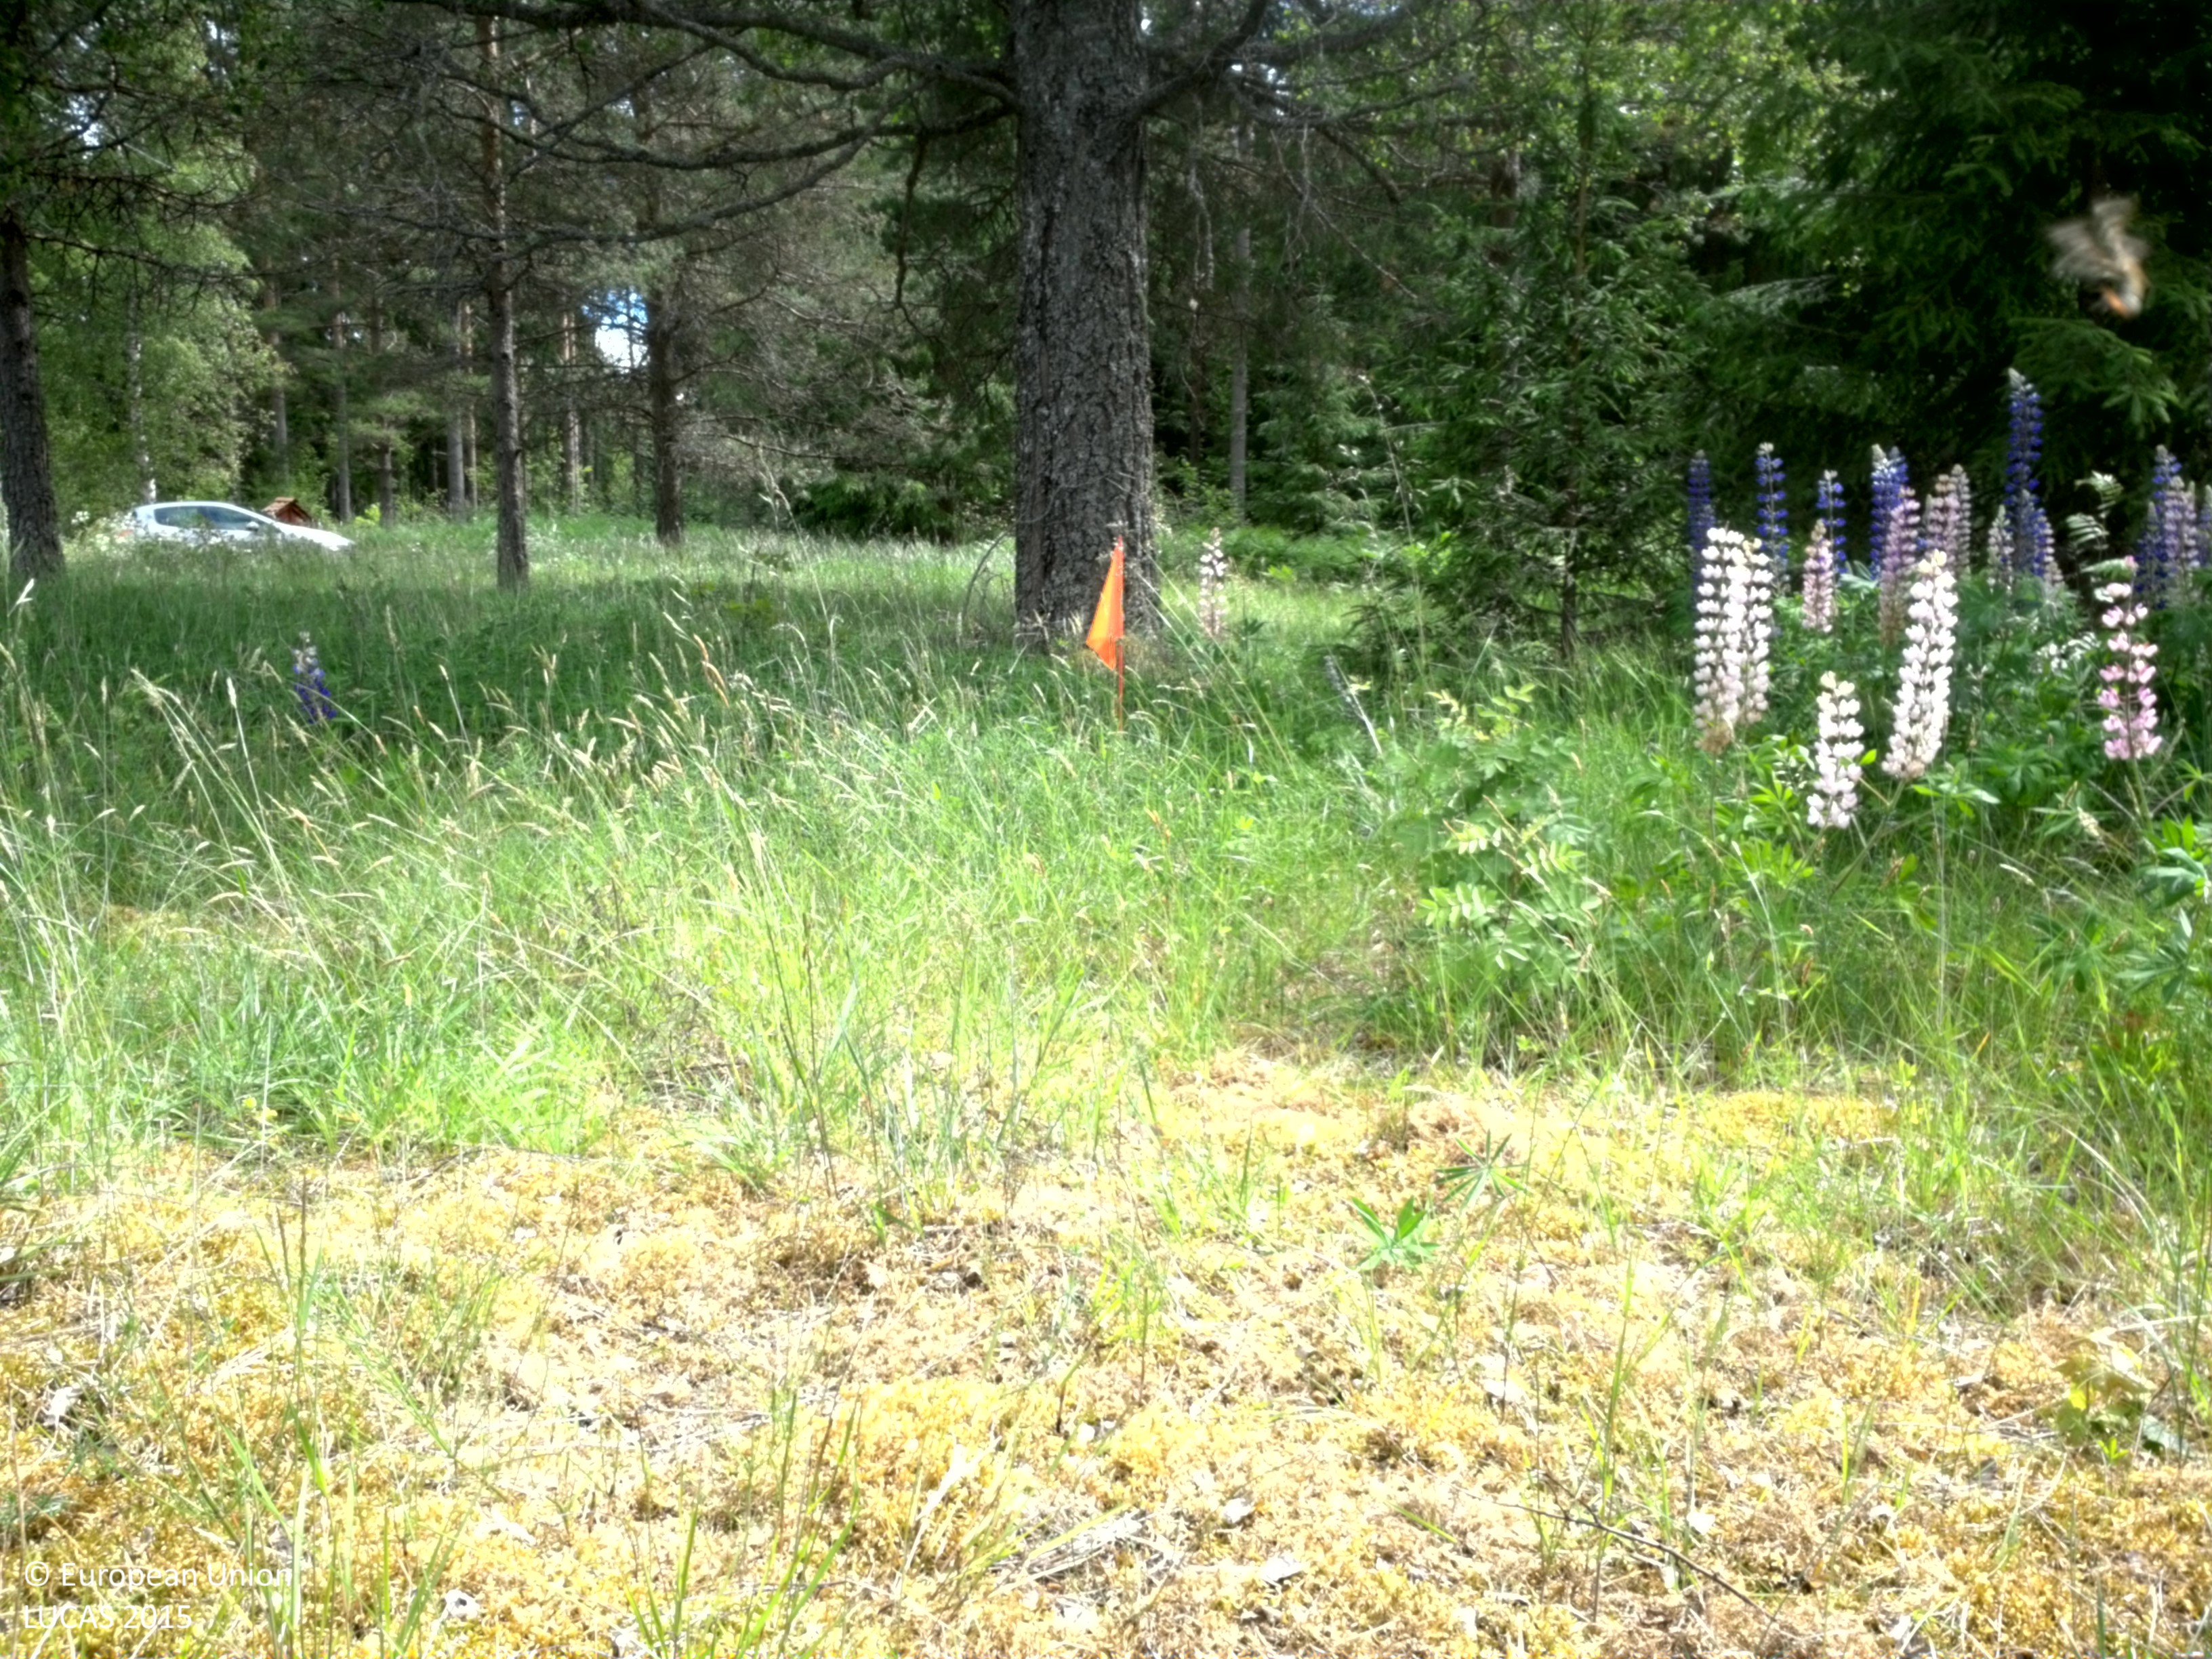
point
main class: Woodland
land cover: Pine dominated mixed woodland
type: boreal forest
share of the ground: 25 - 50 %
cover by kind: herbaceous plants 60 %, coniferous forest trees 25 %, broadleaved forest trees 15 %
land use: Forestry
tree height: > 5 m
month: July
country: SE
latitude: 60.0424
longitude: 17.0112
